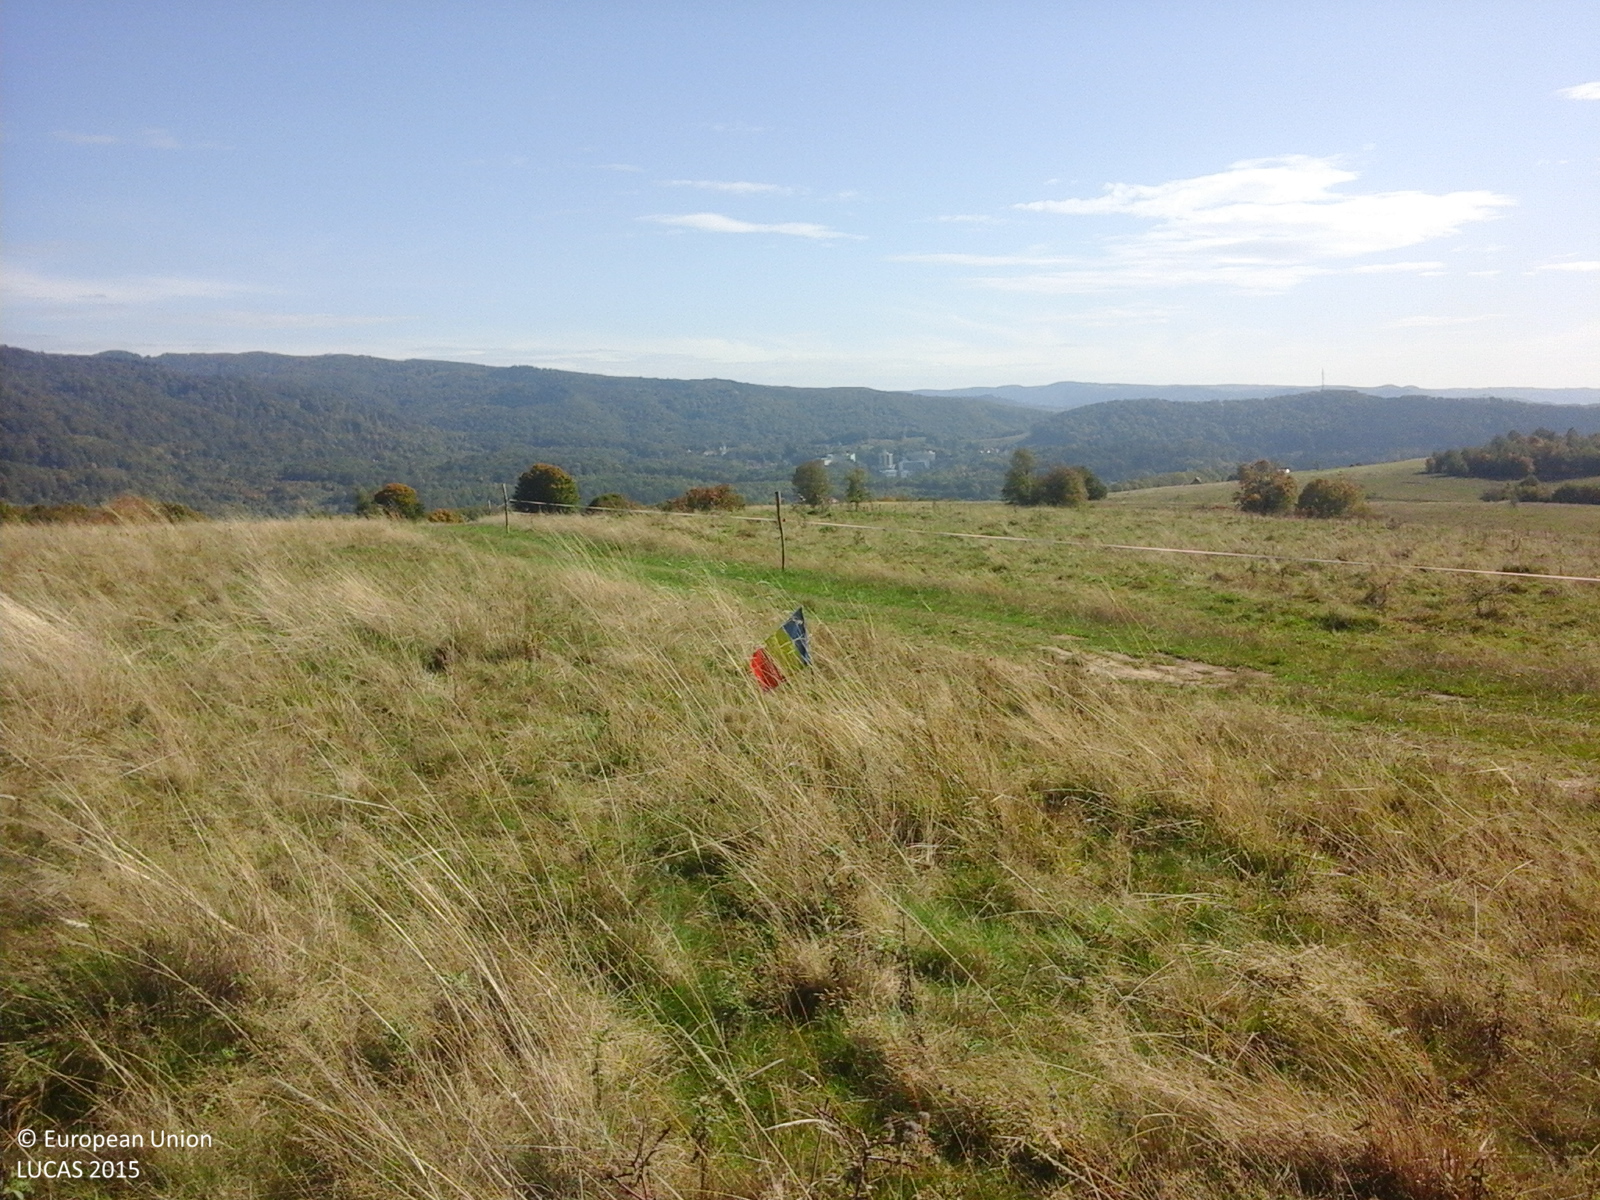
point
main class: Grassland
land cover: Grassland without tree/shrub cover
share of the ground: > 75 %
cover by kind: herbaceous plants 100 %
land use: Agriculture (excluding fallow land and kitchen gardens)
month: October
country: RO
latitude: 46.6152
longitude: 25.0506
